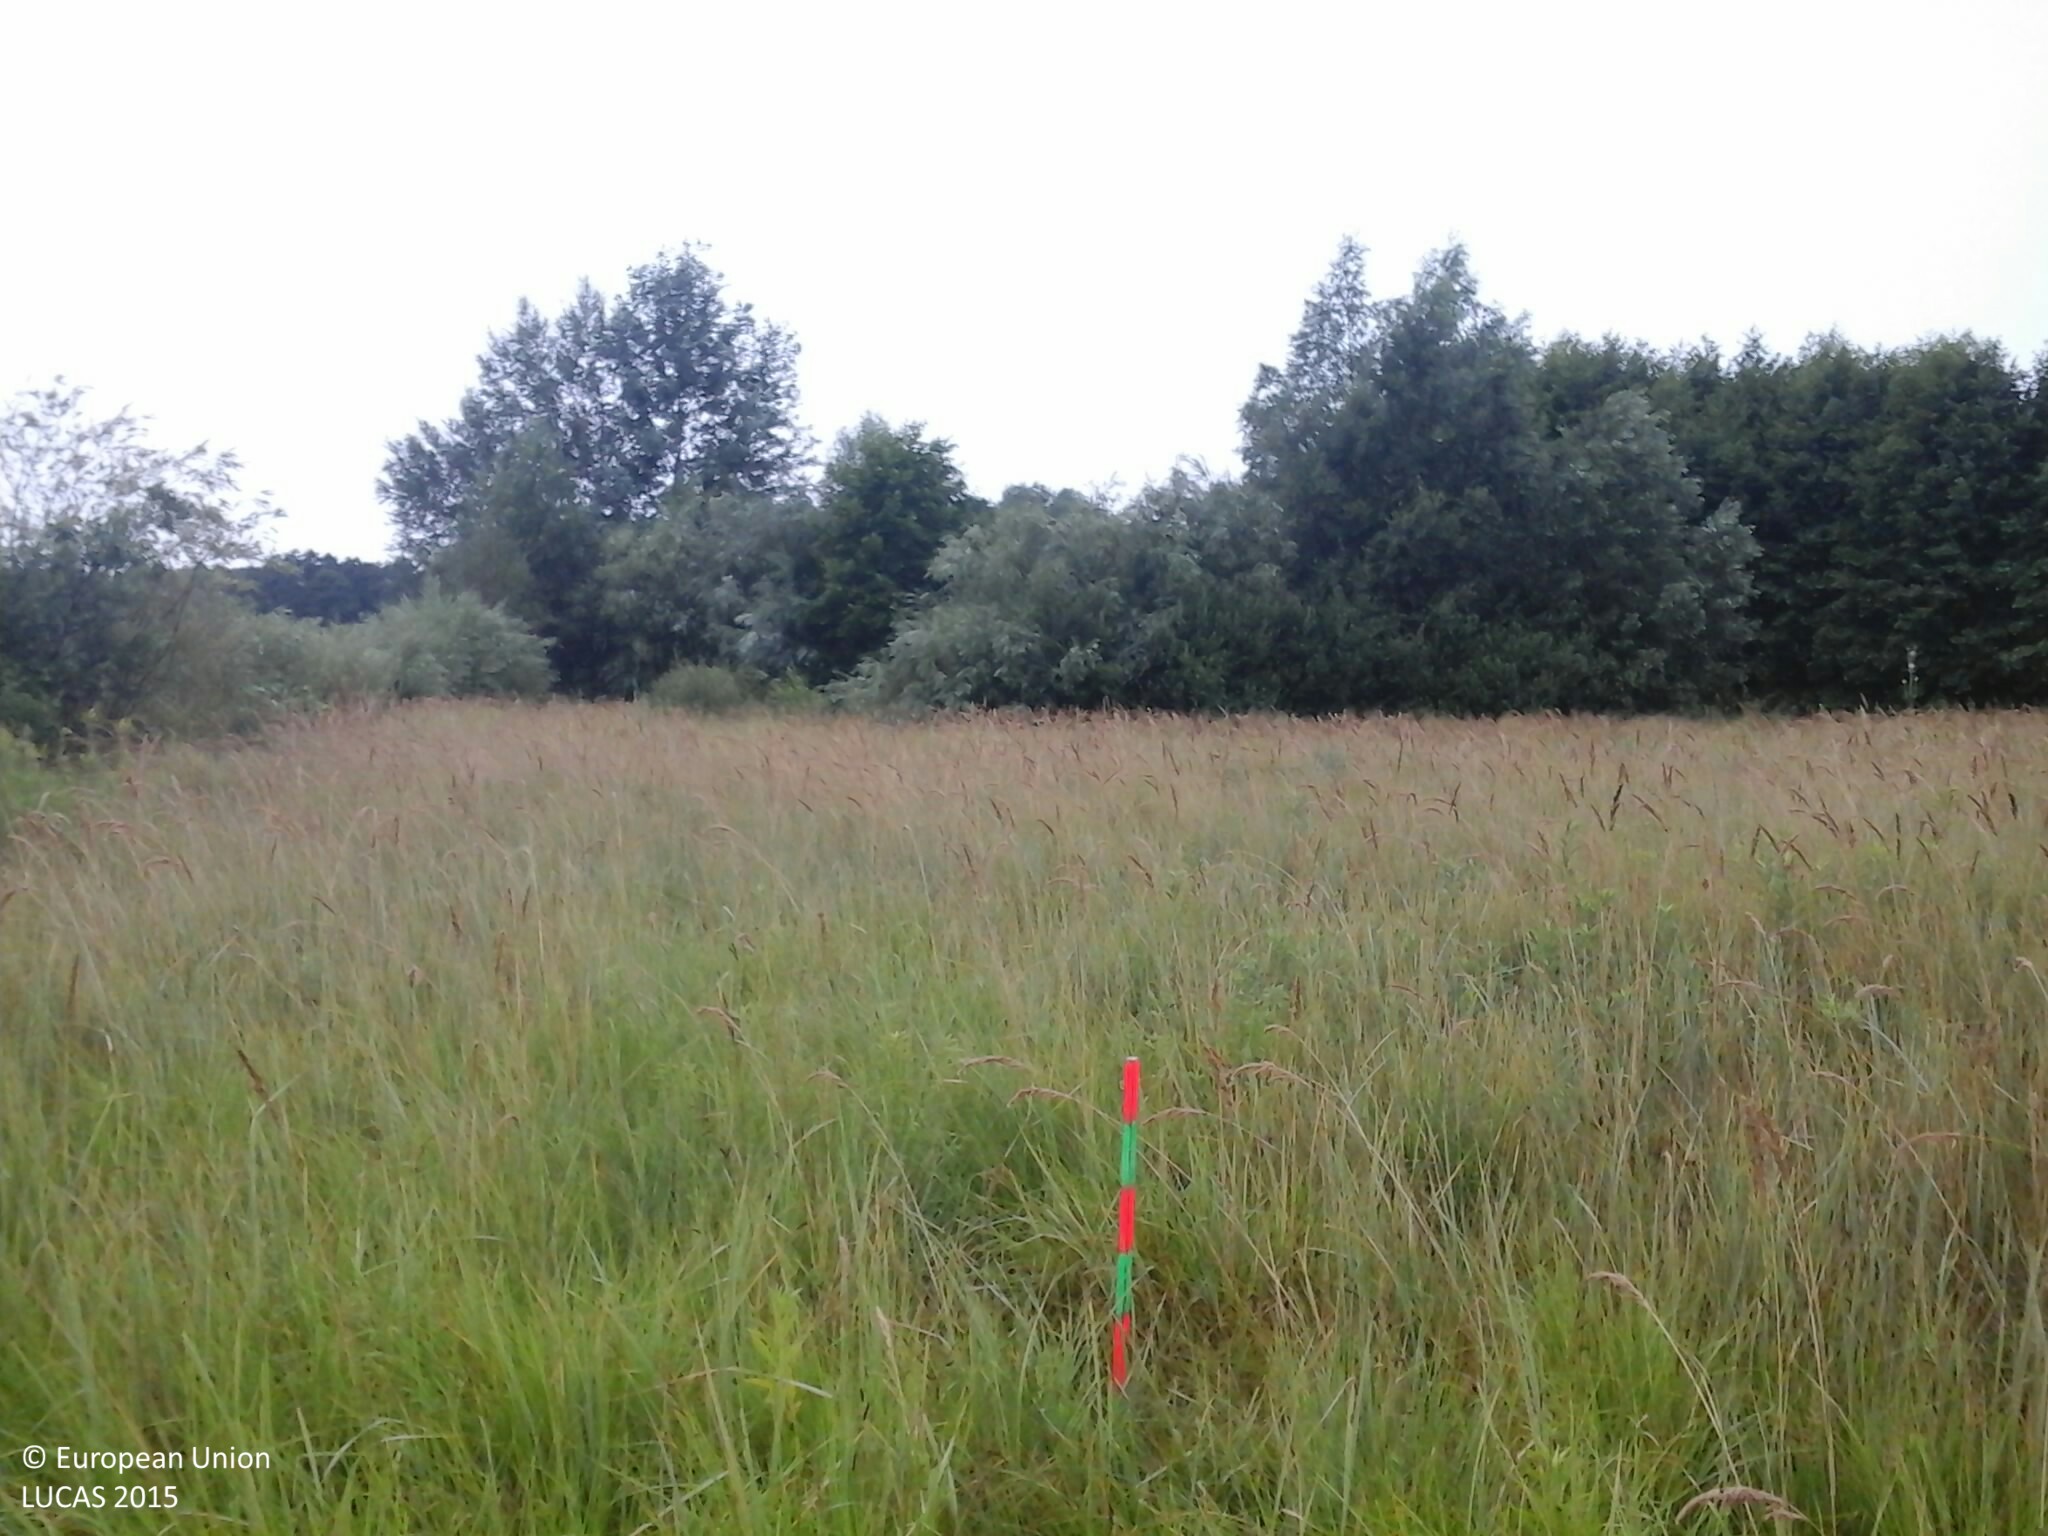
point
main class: Grassland
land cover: Spontaneously vegetated surfaces
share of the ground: > 75 %
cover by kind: herbaceous plants 100 %
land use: Semi-natural and natural areas not in use
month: July
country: HU
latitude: 46.7378
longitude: 17.7678
